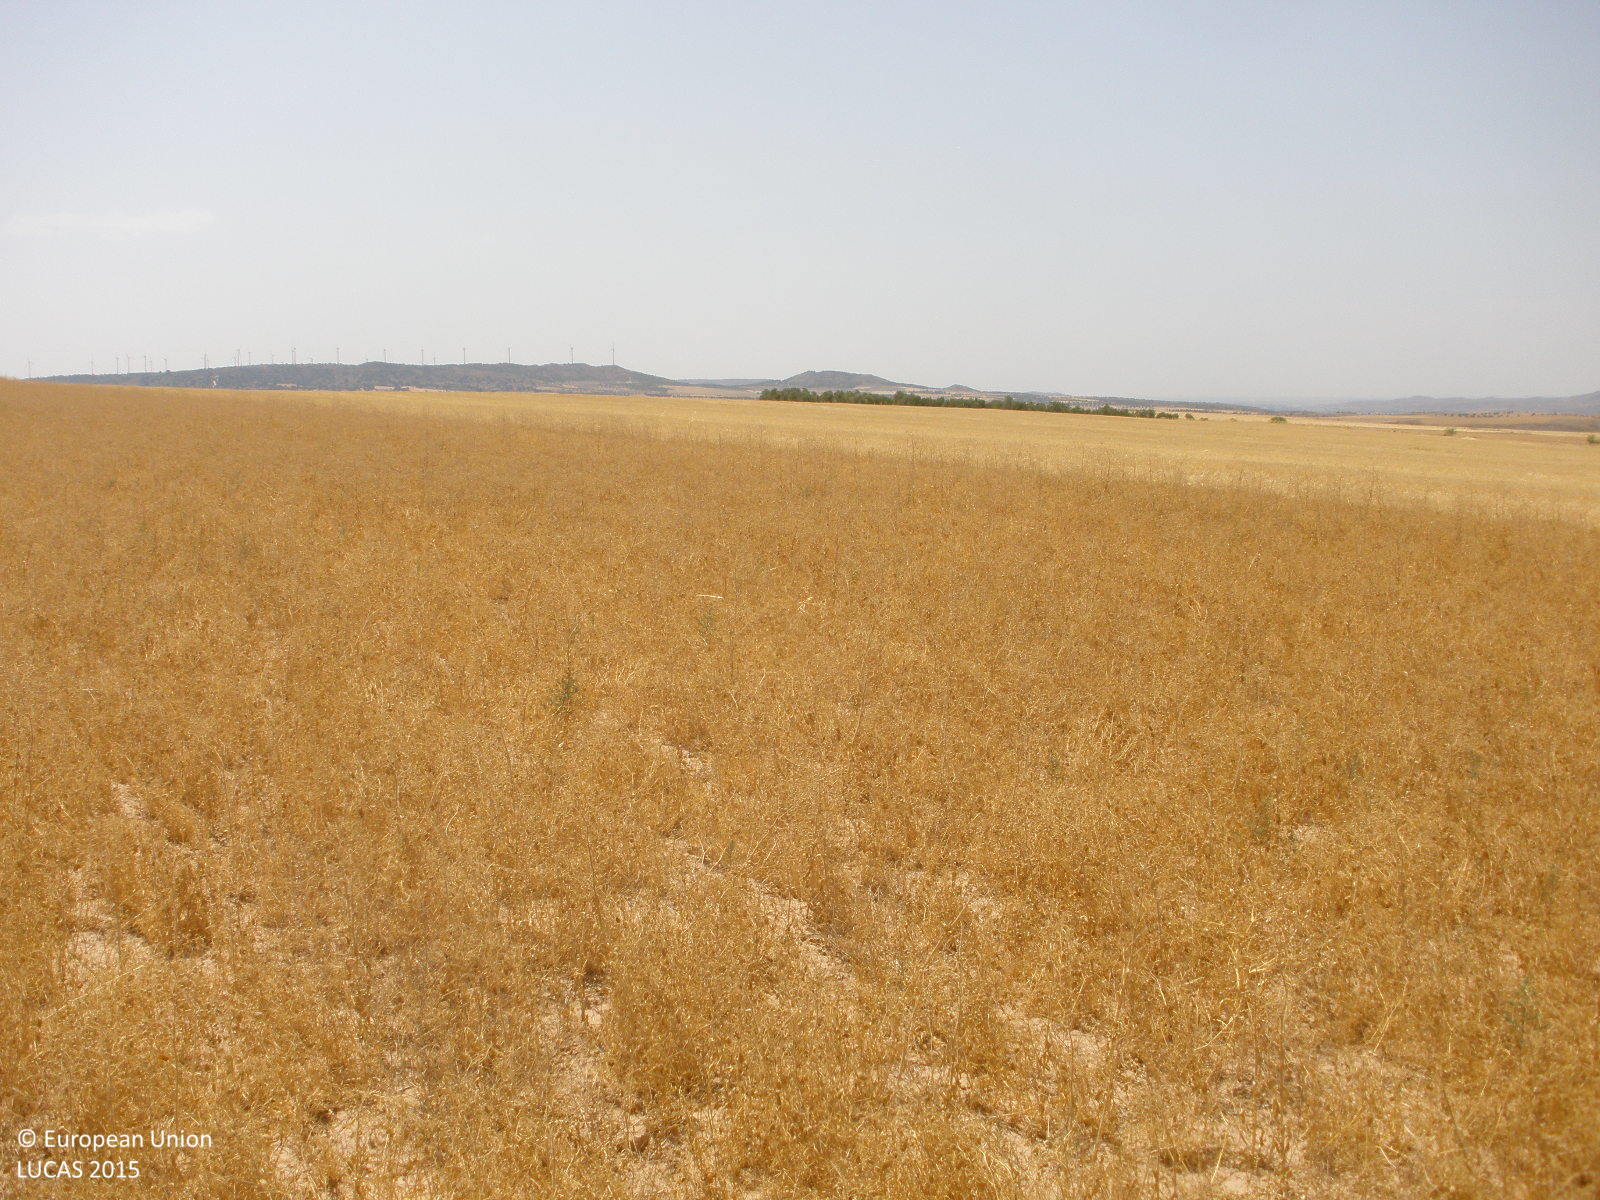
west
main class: Cropland
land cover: Dry pulses
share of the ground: > 75 %
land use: Agriculture (excluding fallow land and kitchen gardens)
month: July
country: ES
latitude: 40.0195
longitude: -3.2785
